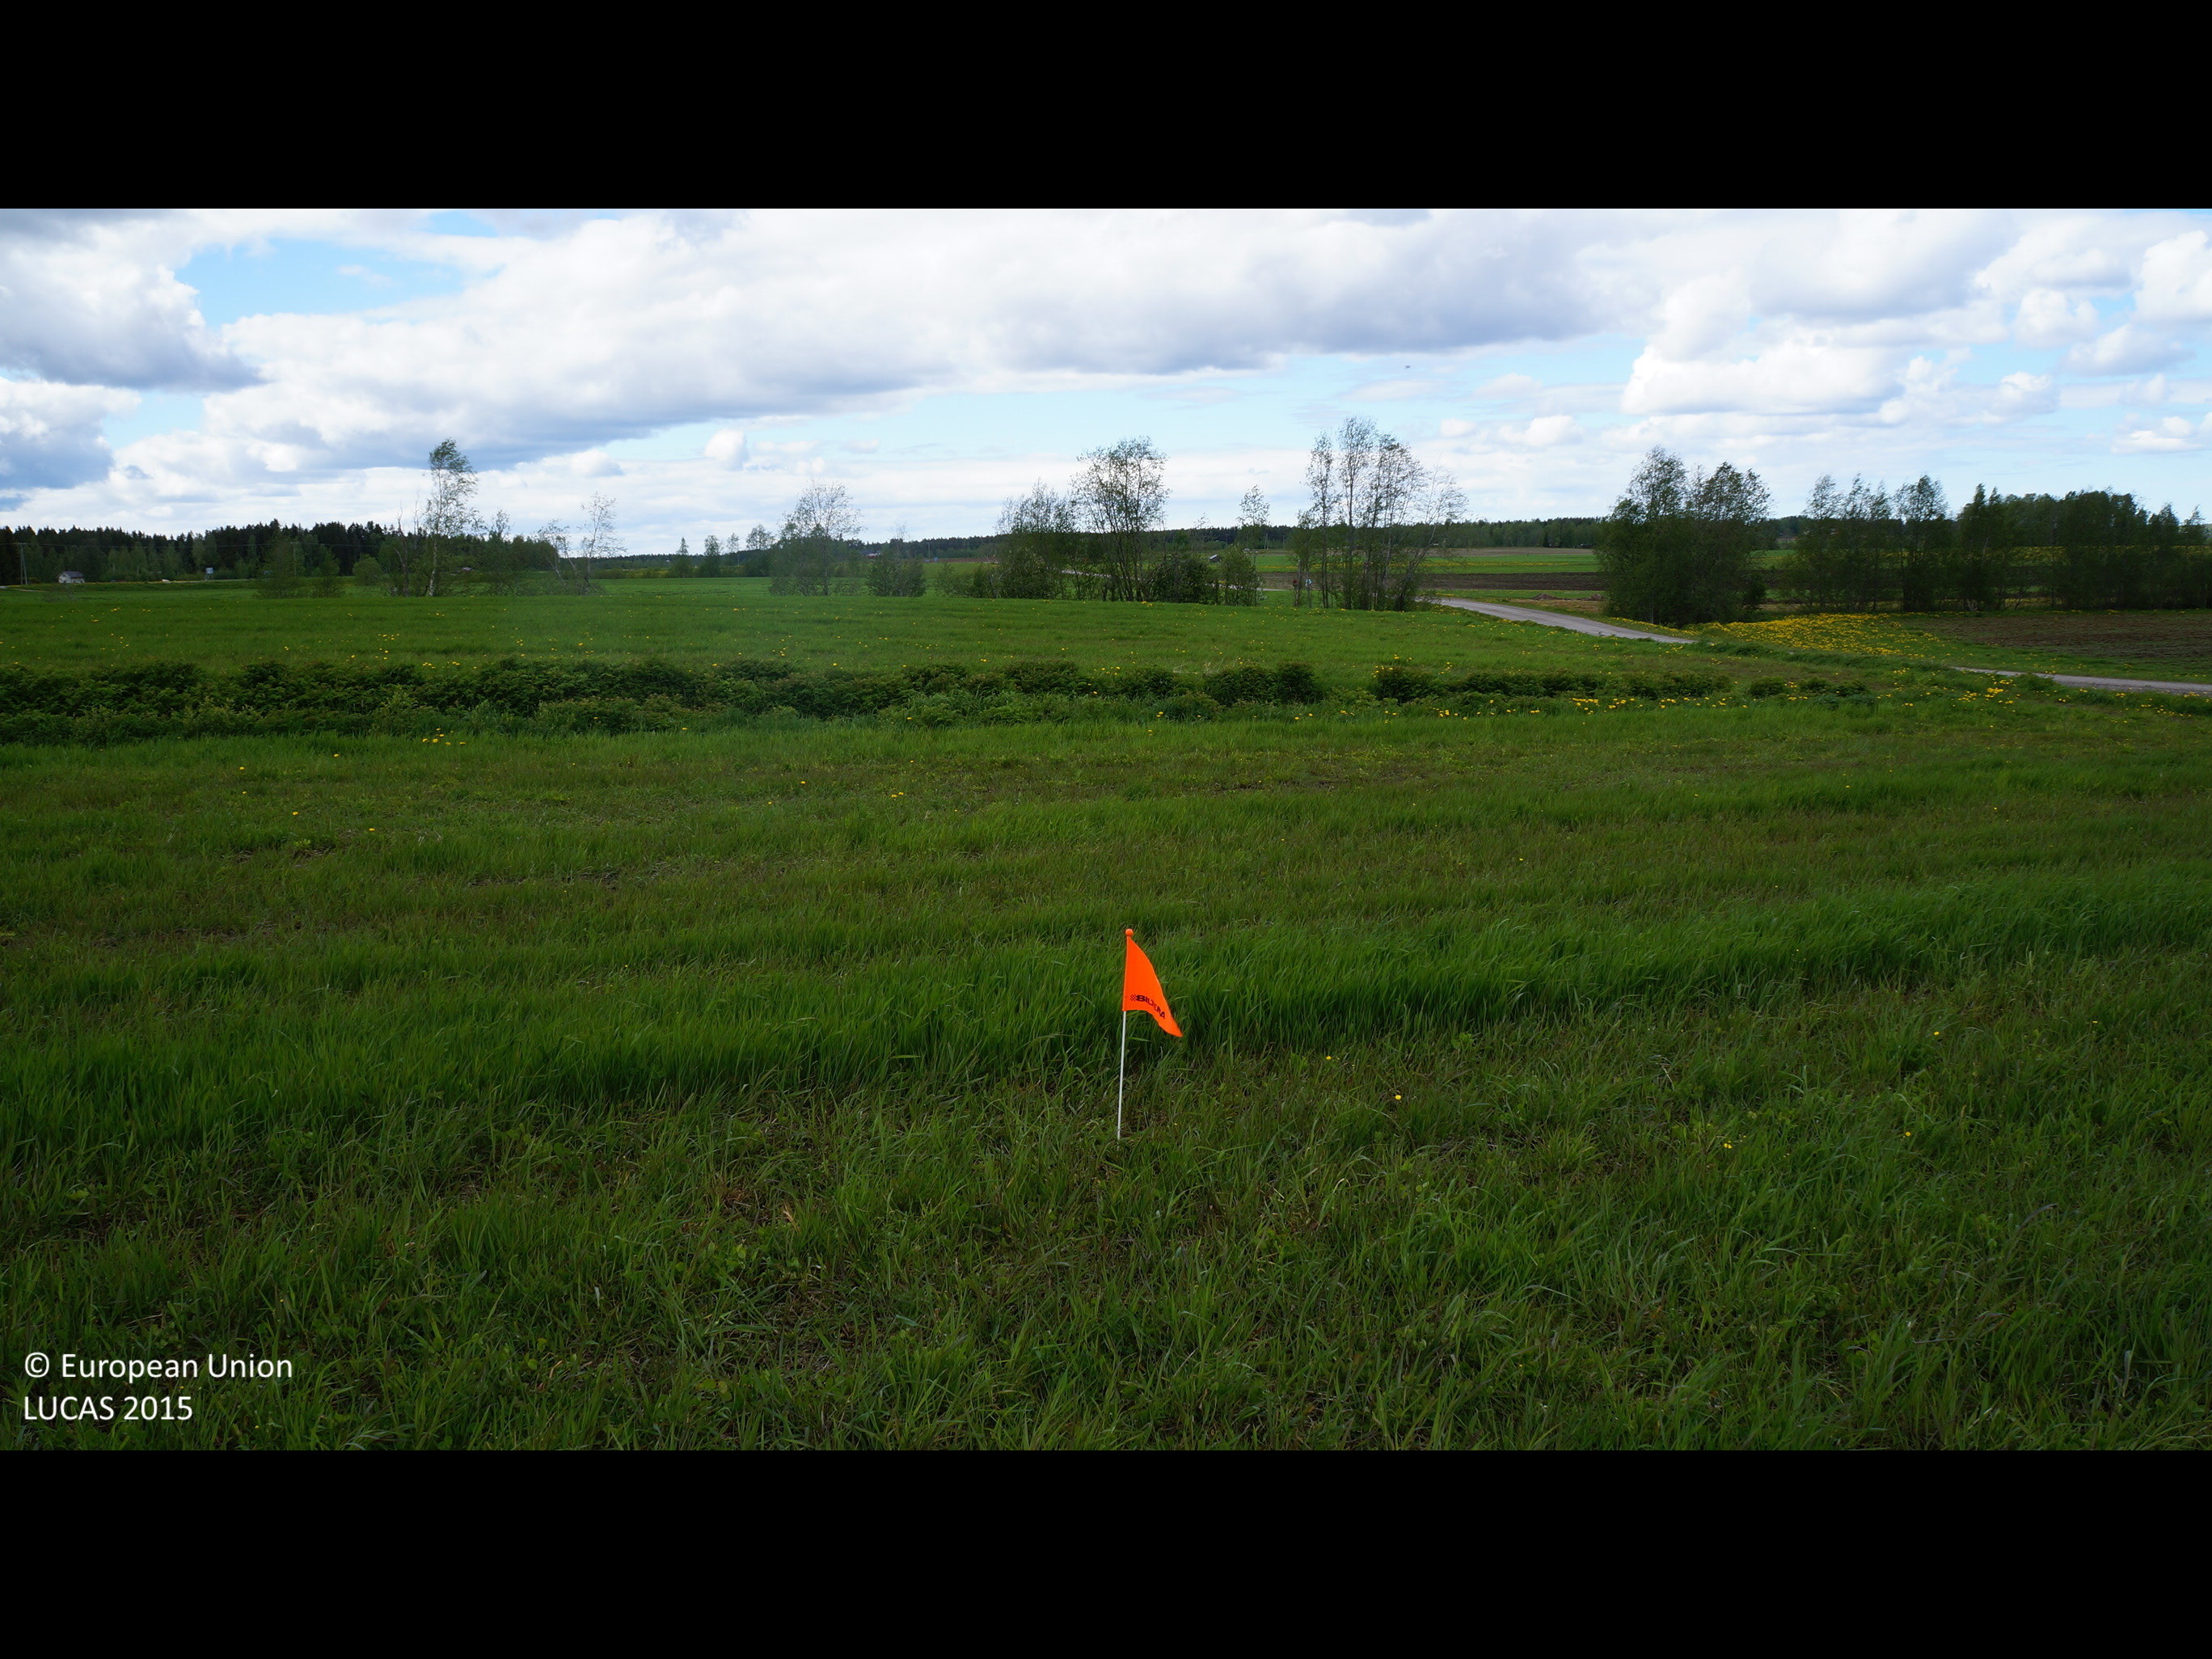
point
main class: Cropland
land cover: Temporary grasslands
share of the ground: > 75 %
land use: Agriculture (excluding fallow land and kitchen gardens)
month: June
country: FI
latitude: 63.7942
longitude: 24.1770
